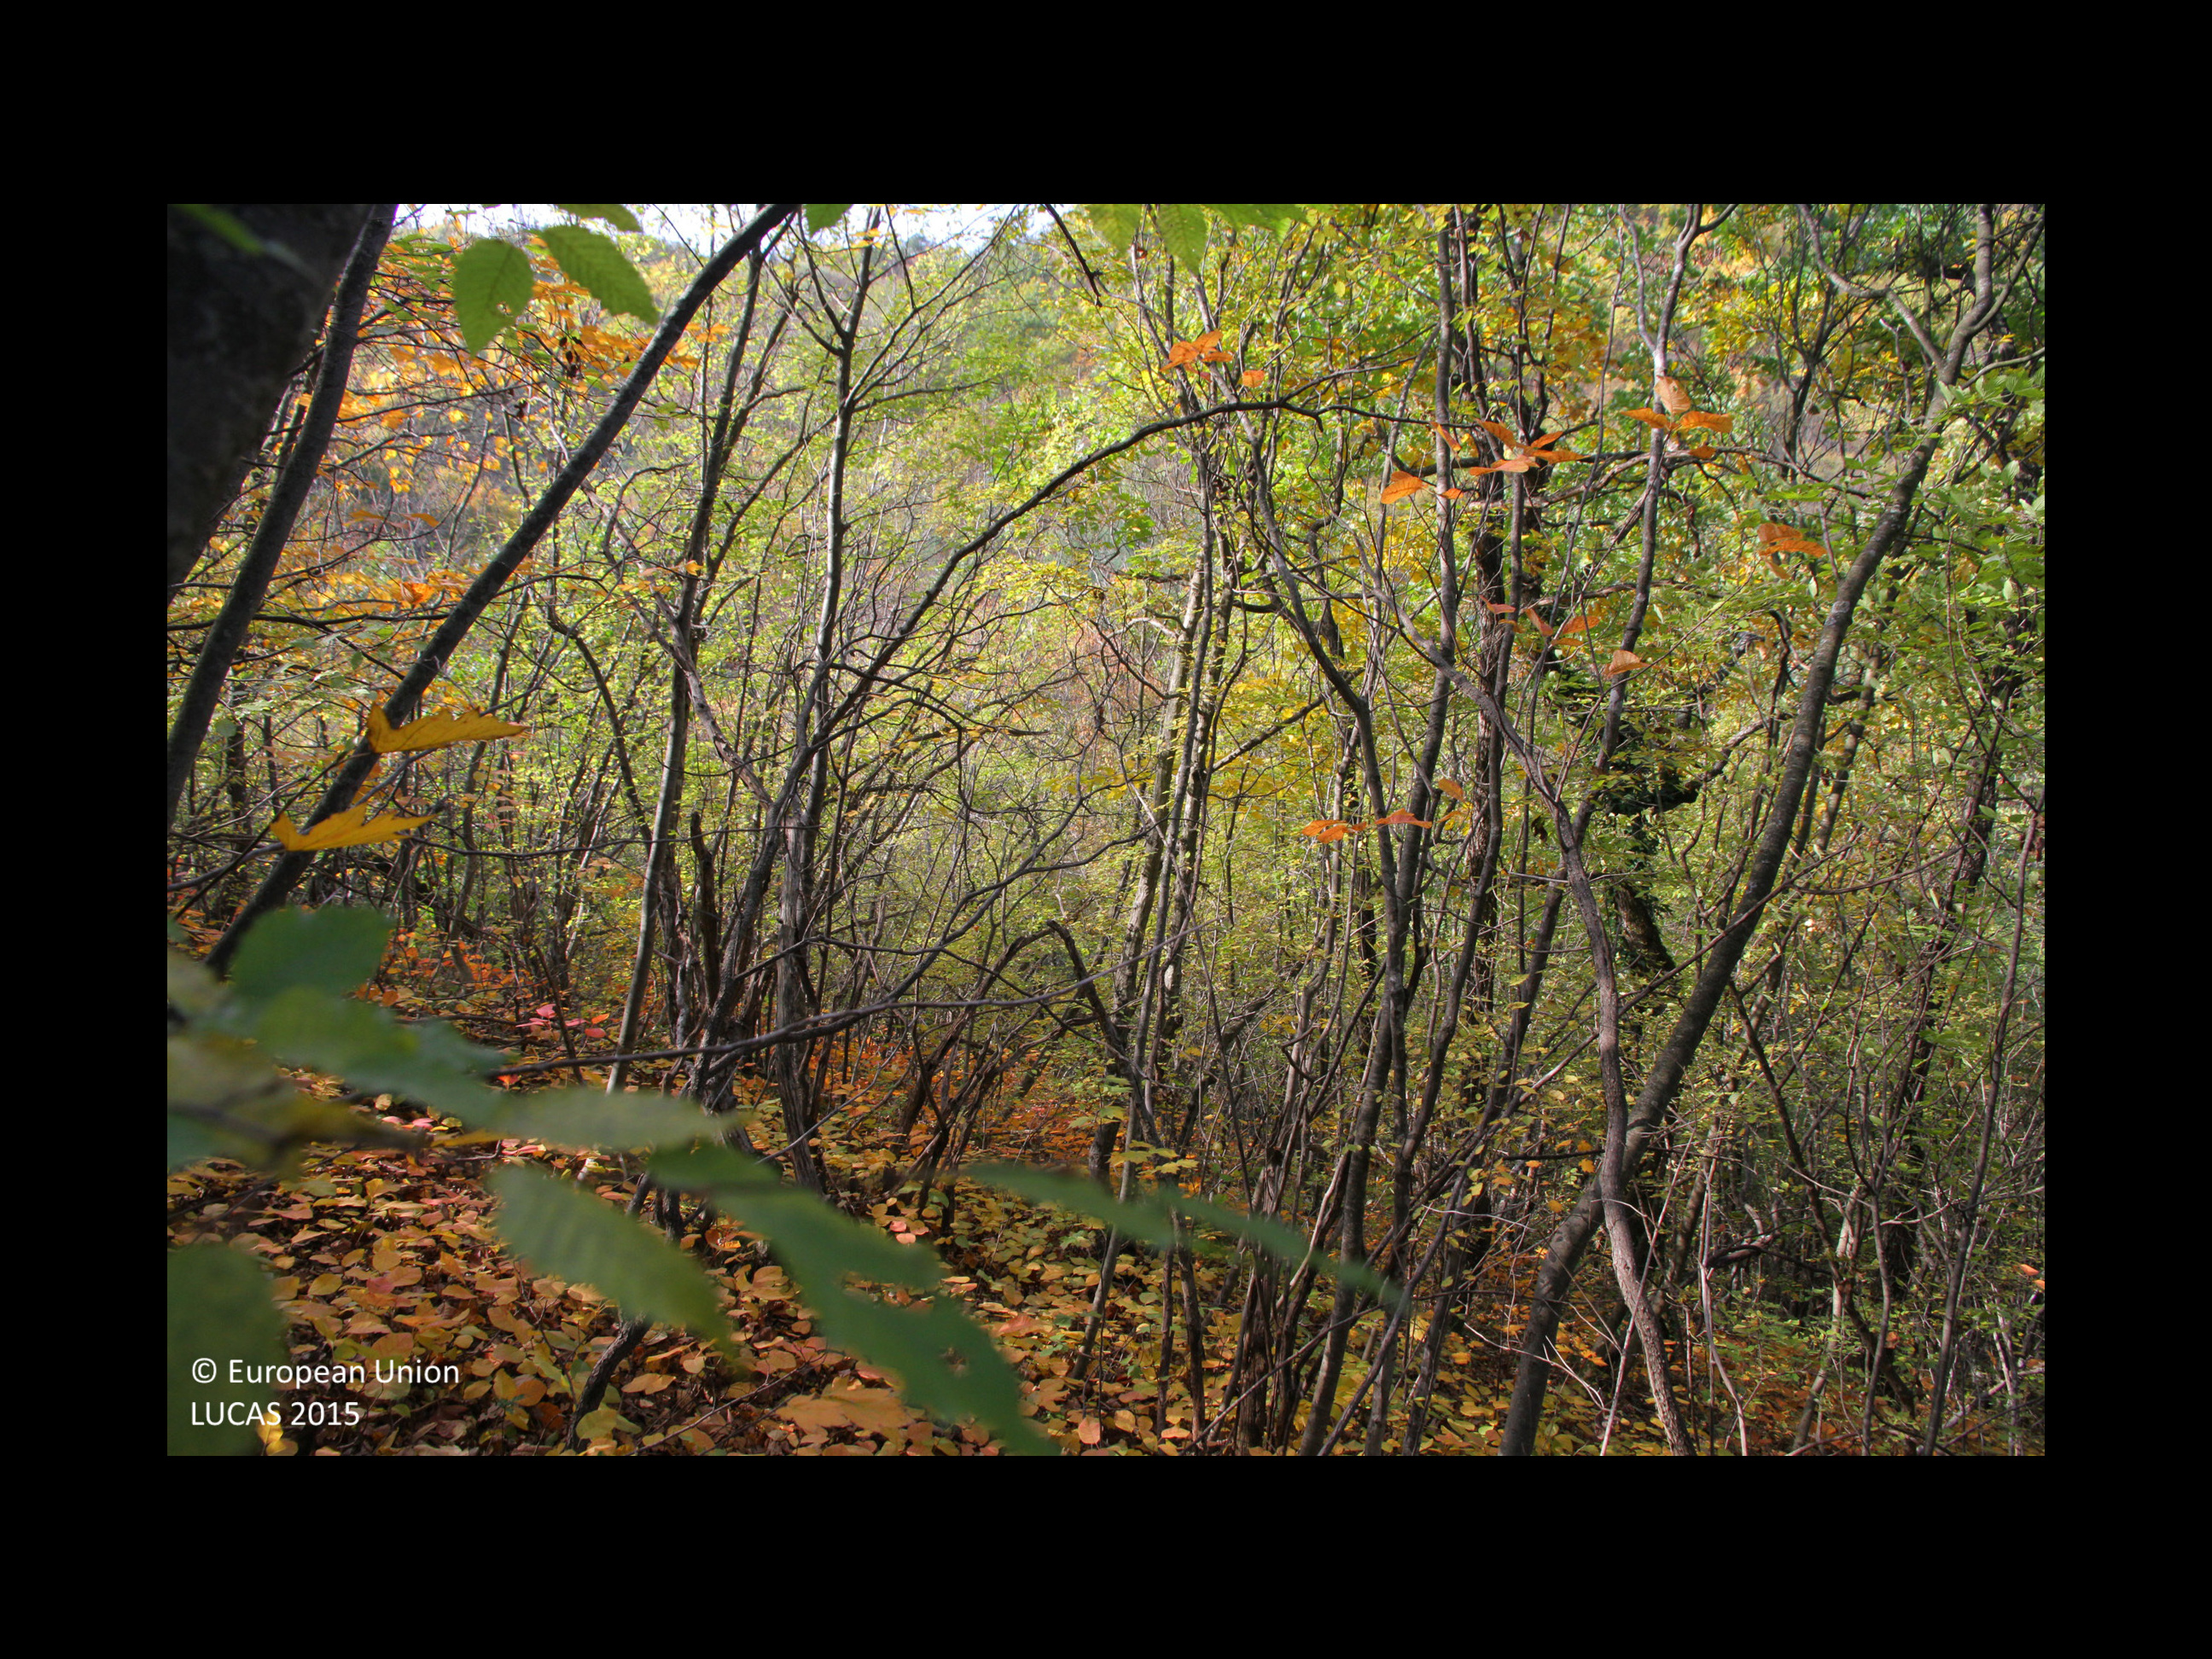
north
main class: Woodland
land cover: Broadleaved woodland
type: mesophytic deciduous forest
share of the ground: > 75 %
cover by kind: broadleaved forest trees 100 %
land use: Forestry
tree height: > 5 m
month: October
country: BG
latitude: 43.1320
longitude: 26.8144
